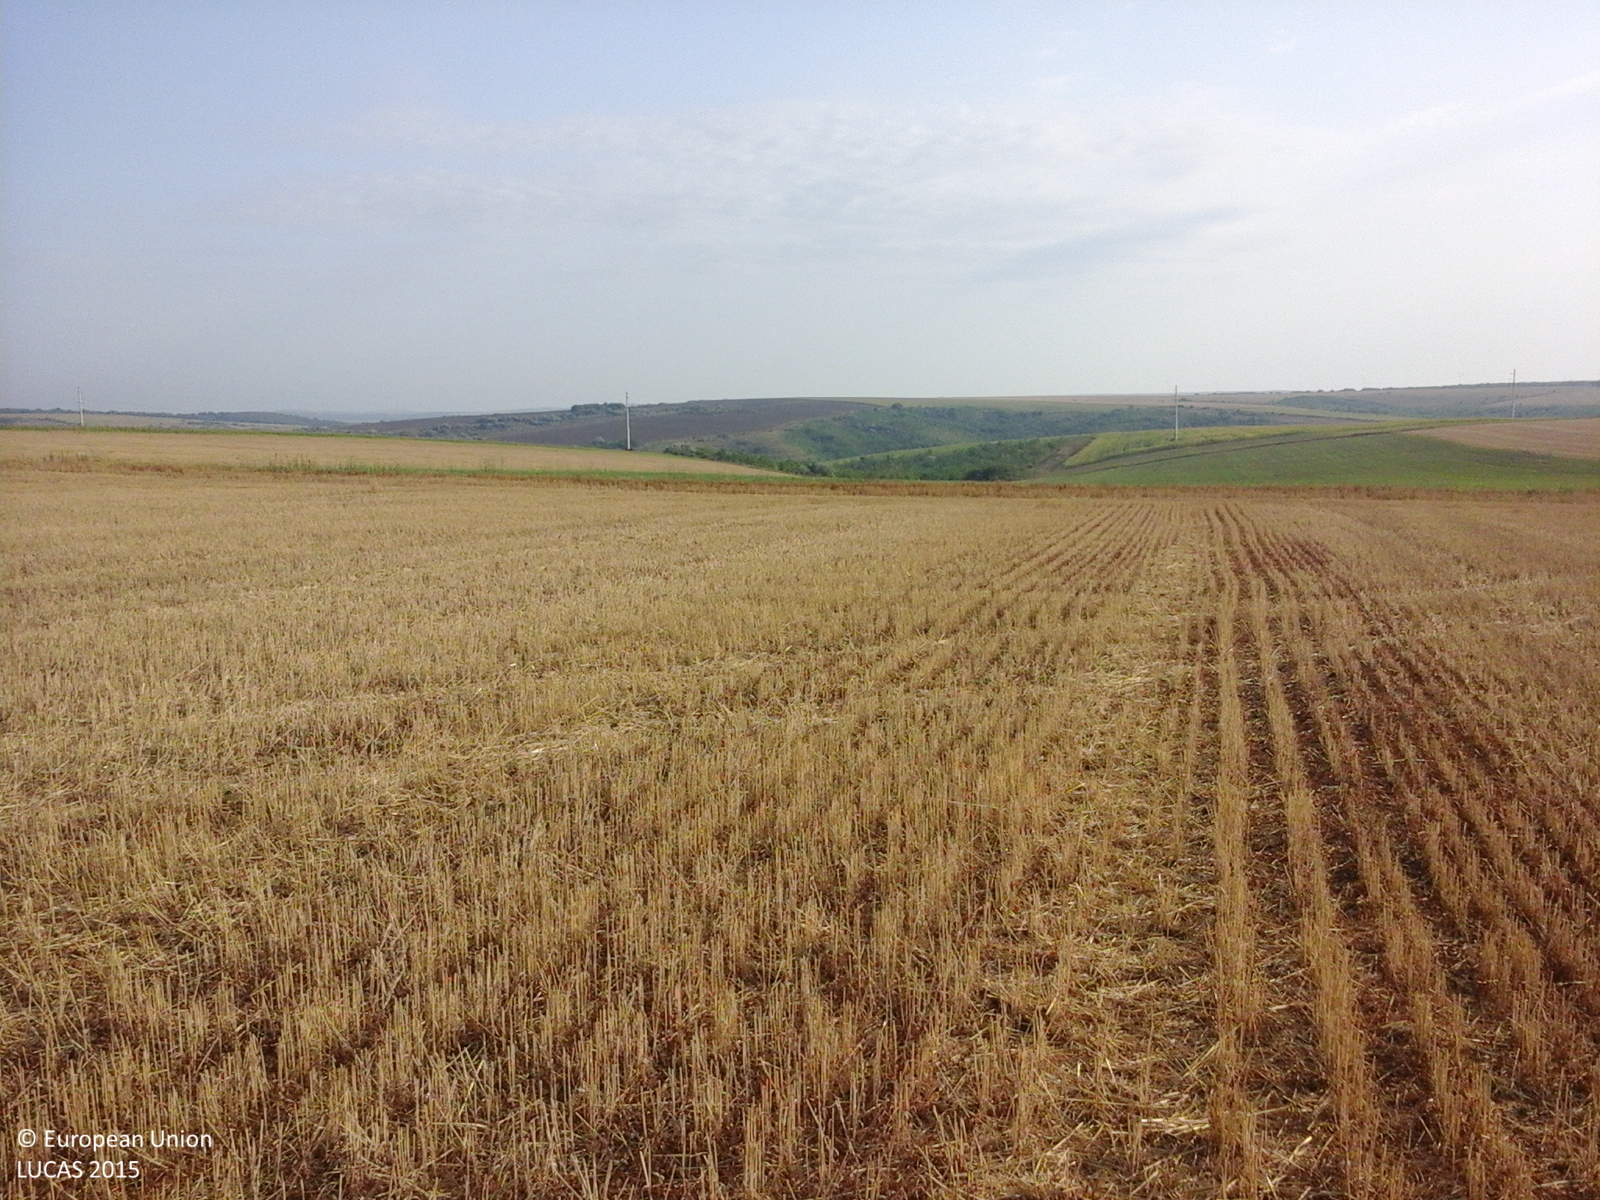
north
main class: Cropland
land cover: Common wheat
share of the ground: 50 - 75 %
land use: Agriculture (excluding fallow land and kitchen gardens)
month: August
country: RO
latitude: 44.1145
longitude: 27.9573
